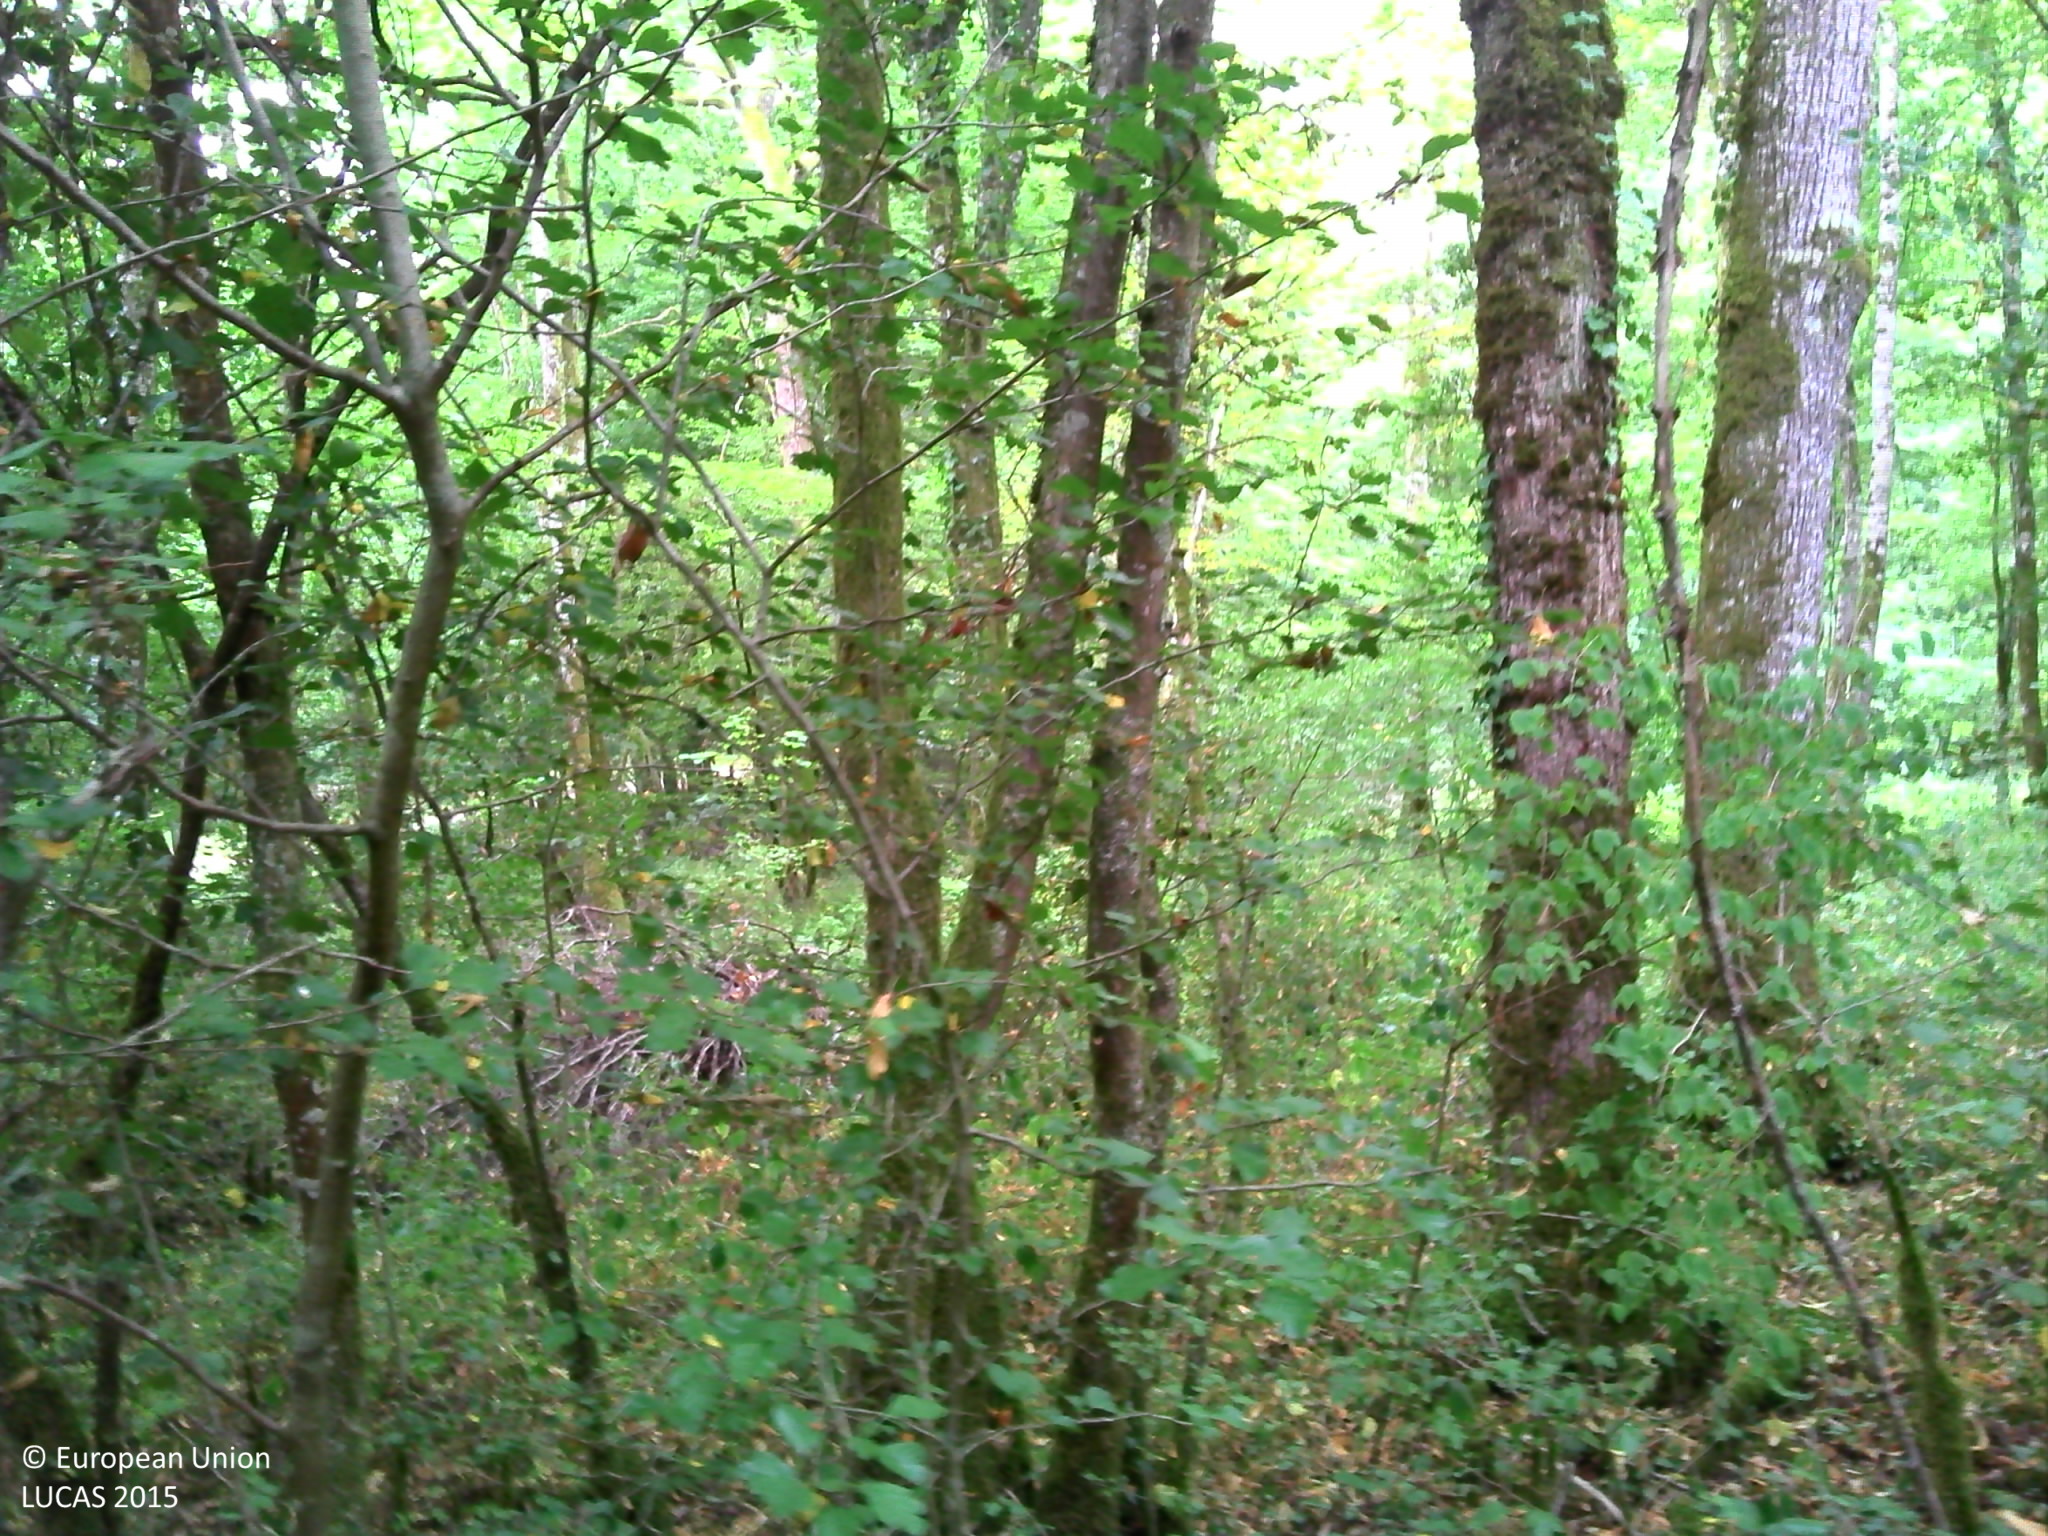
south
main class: Woodland
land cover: Broadleaved woodland
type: mesophytic deciduous forest
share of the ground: > 75 %
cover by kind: broadleaved forest trees 80 %, herbaceous plants 10 %, lichens and mosses 10 %
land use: Forestry
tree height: > 5 m
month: July
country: FR
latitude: 47.9408
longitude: 5.2472
